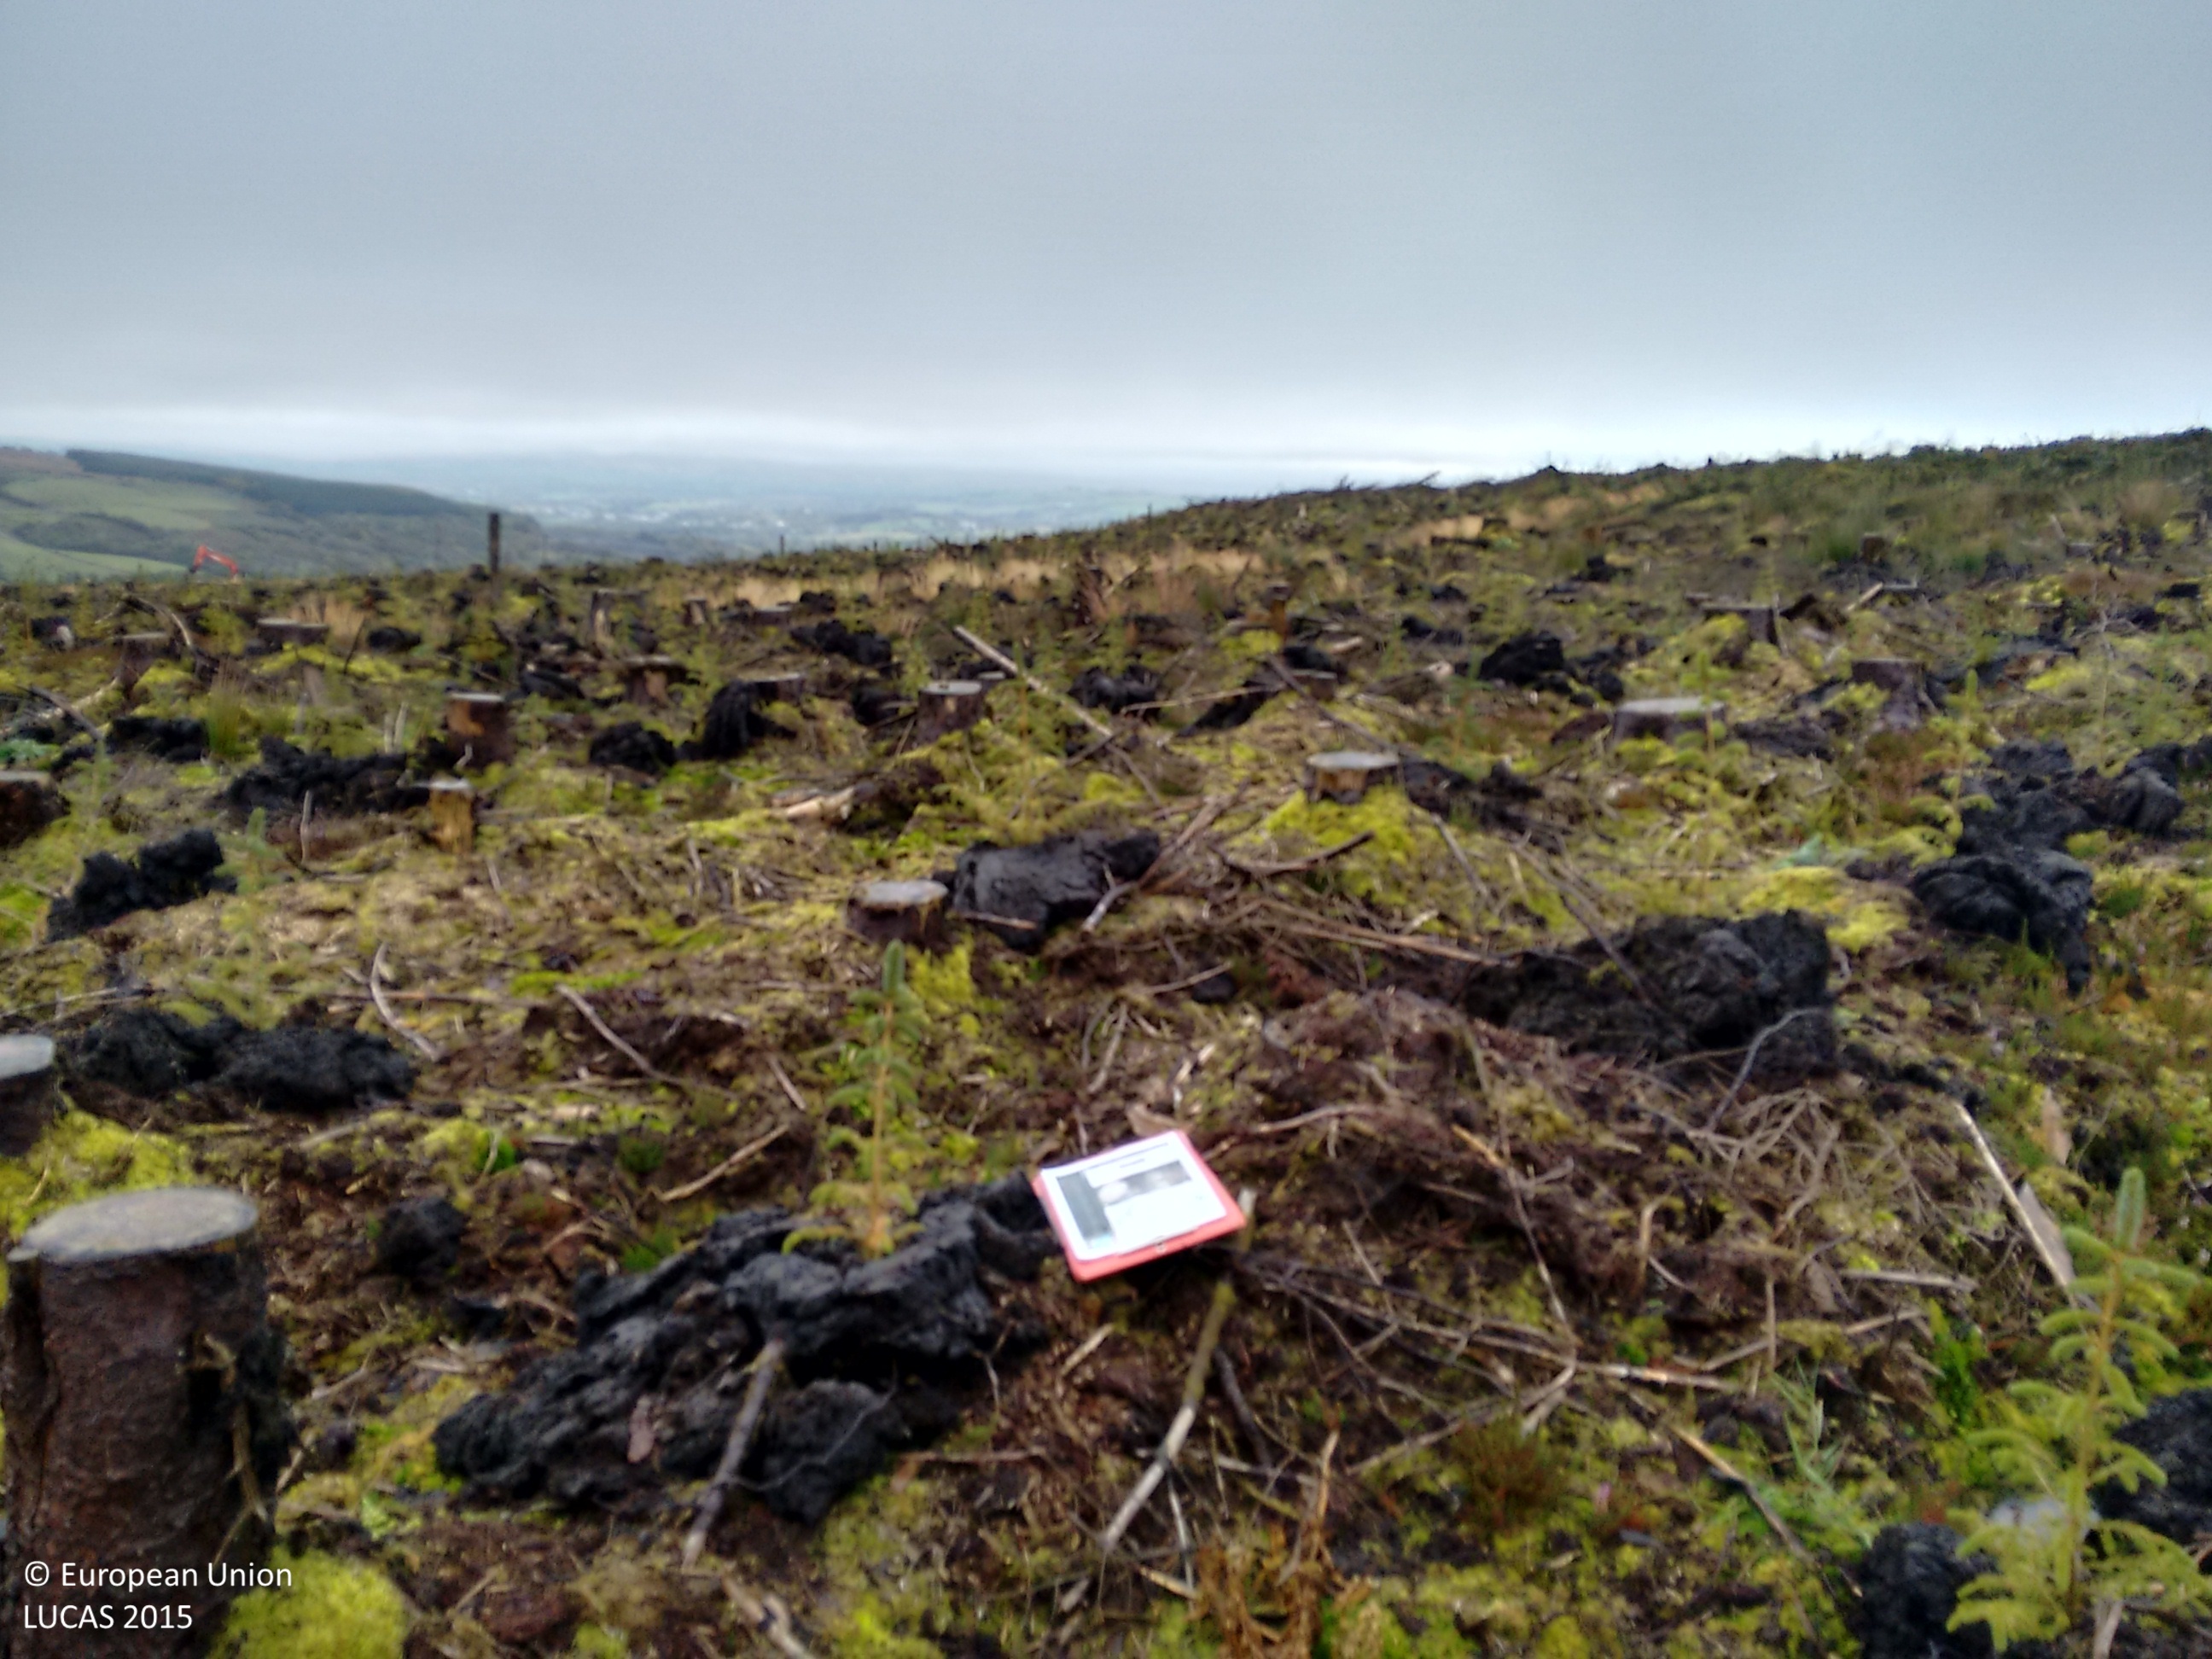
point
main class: Shrubland
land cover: Shrubland without tree cover
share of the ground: > 75 %
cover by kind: shrubs 80 %, lichens and mosses 20 %
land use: Forestry
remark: Clear cut
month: October
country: GB
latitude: 54.5785
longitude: -7.5306
